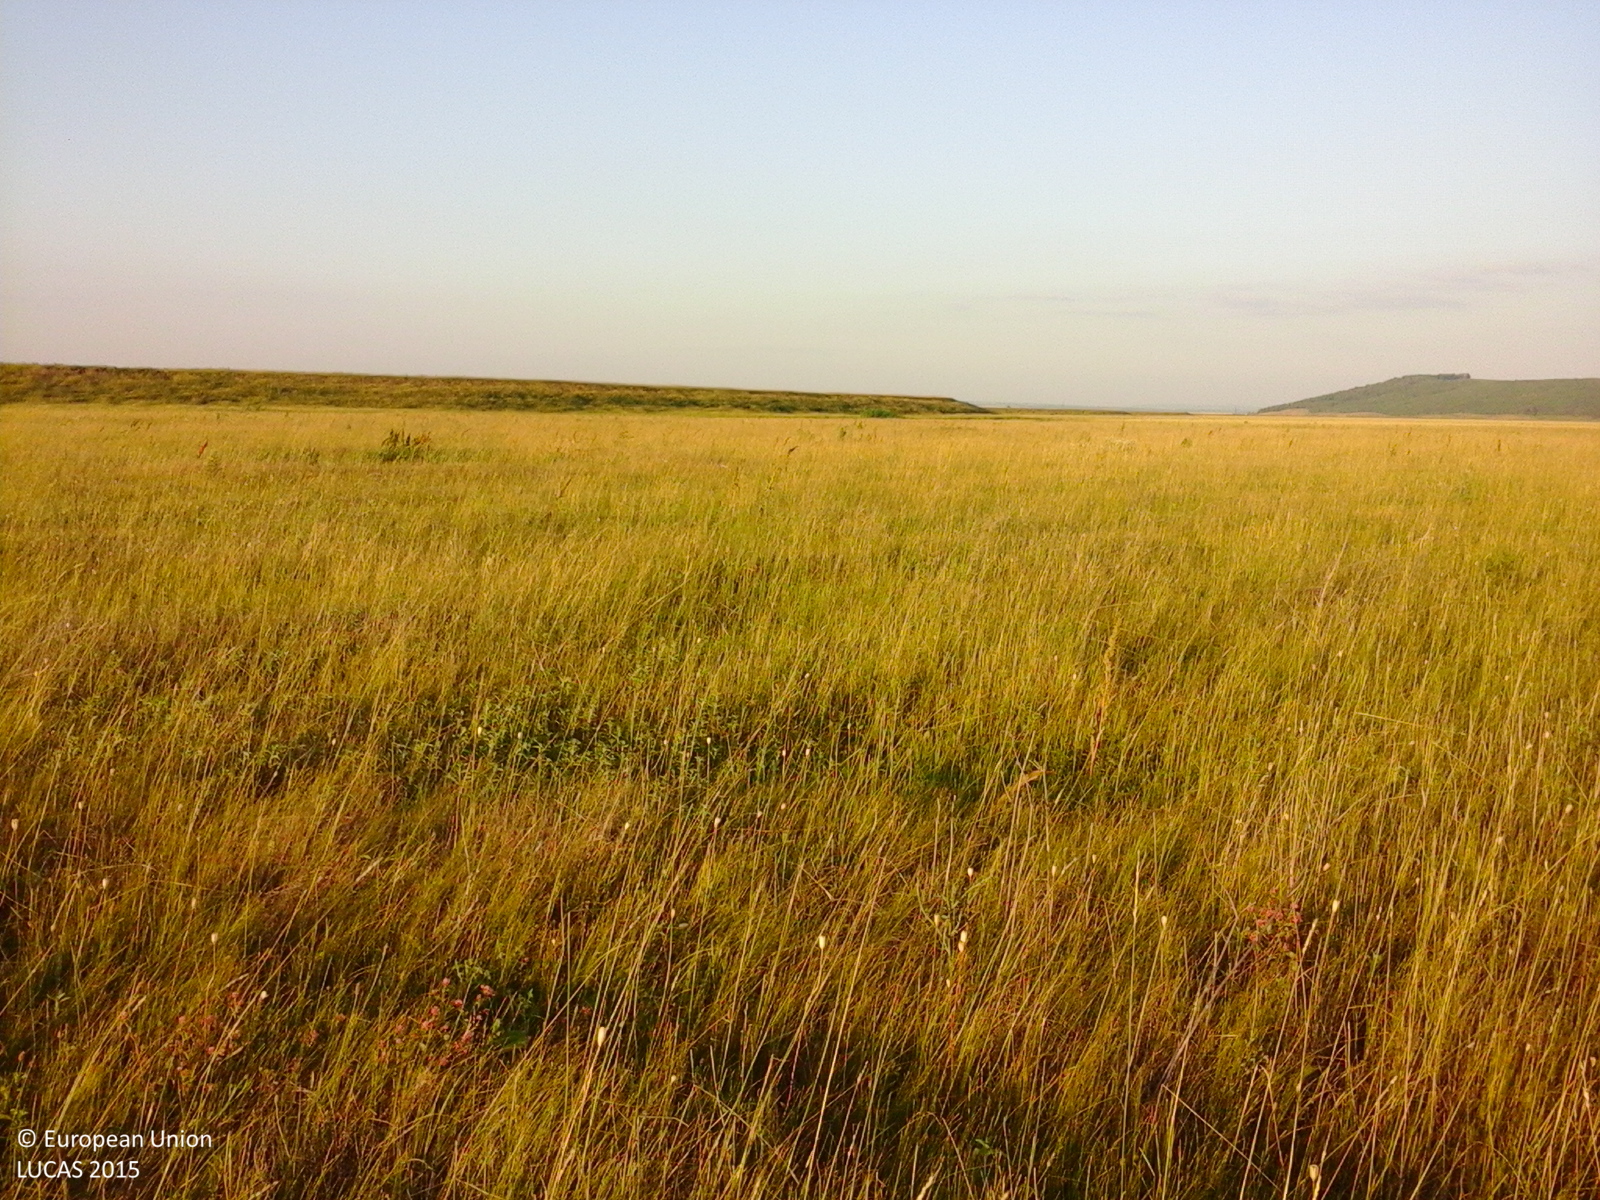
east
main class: Grassland
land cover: Grassland without tree/shrub cover
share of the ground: > 75 %
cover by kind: herbaceous plants 100 %
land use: Agriculture (excluding fallow land and kitchen gardens)
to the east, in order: Grassland without tree/shrub cover
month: June
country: RO
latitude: 47.3129
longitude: 27.4580
